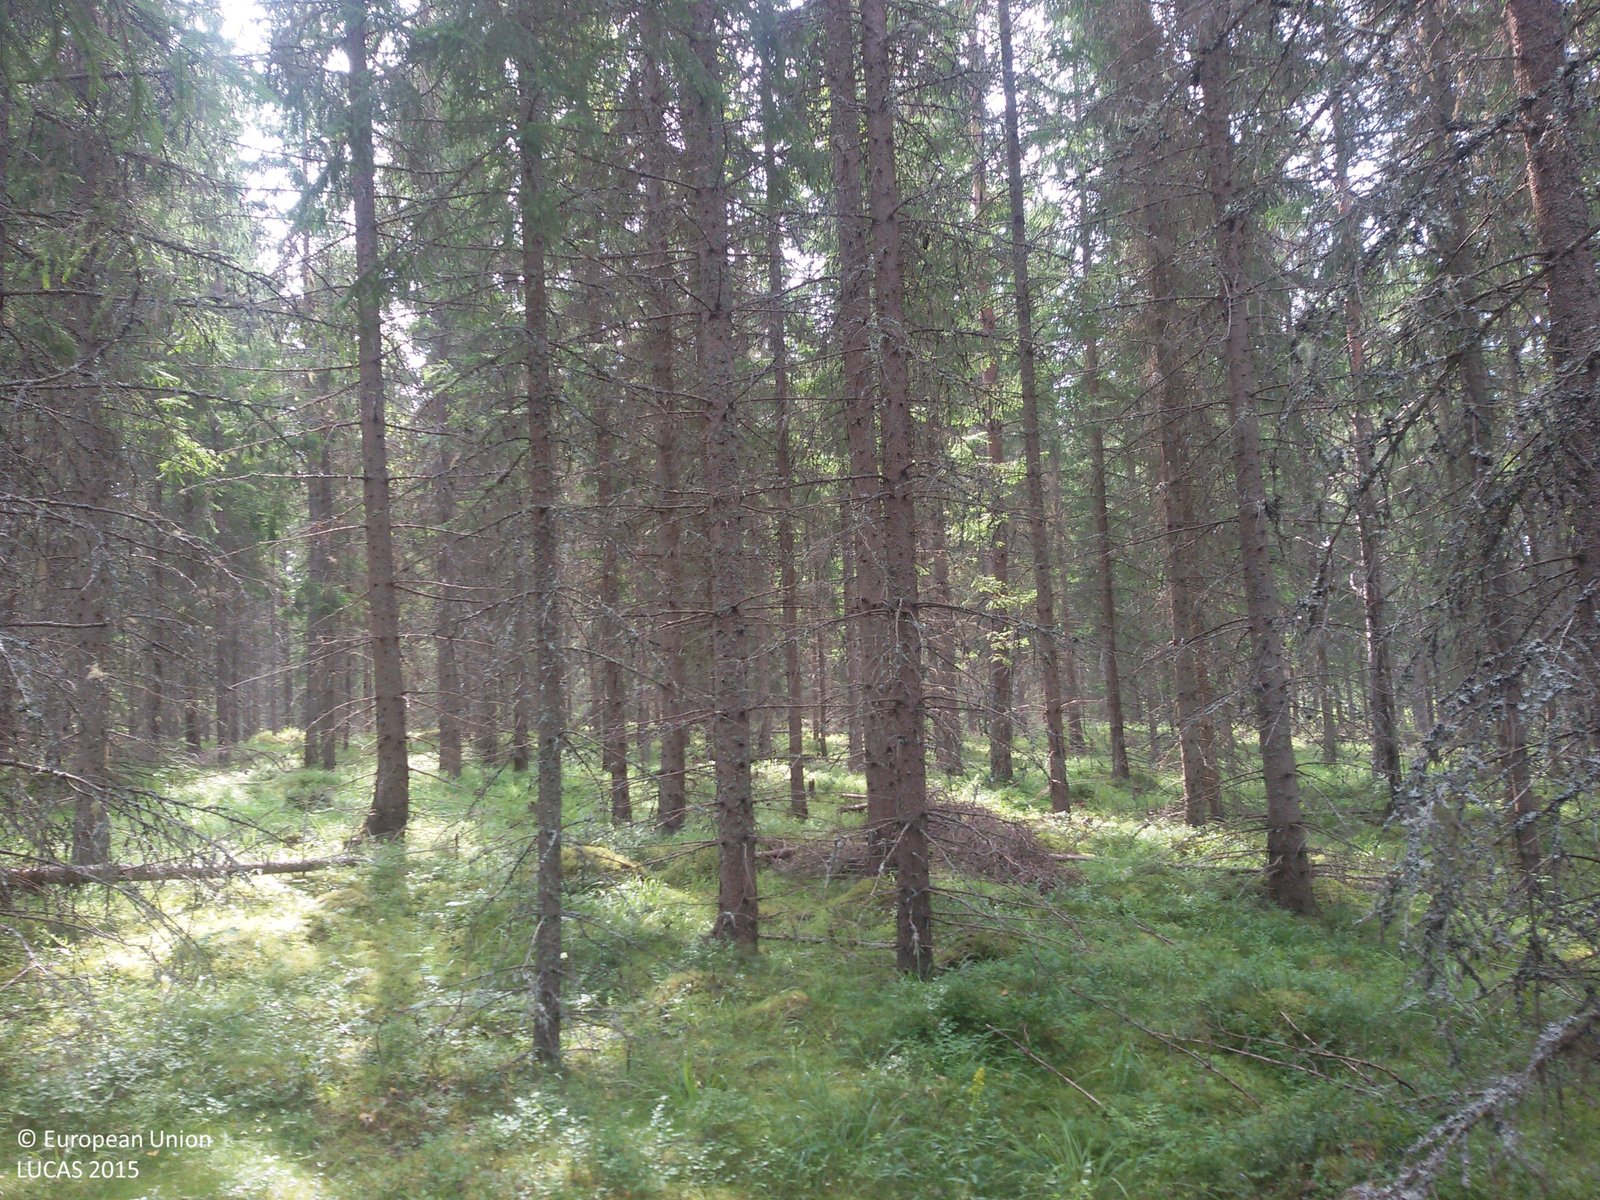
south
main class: Woodland
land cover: Spruce dominated coniferous woodland
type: boreal forest
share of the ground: > 75 %
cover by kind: coniferous forest trees 80 %, herbaceous plants 15 %, shrubs 5 %
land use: Forestry
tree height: > 5 m
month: August
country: SE
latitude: 60.4571
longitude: 16.6616
